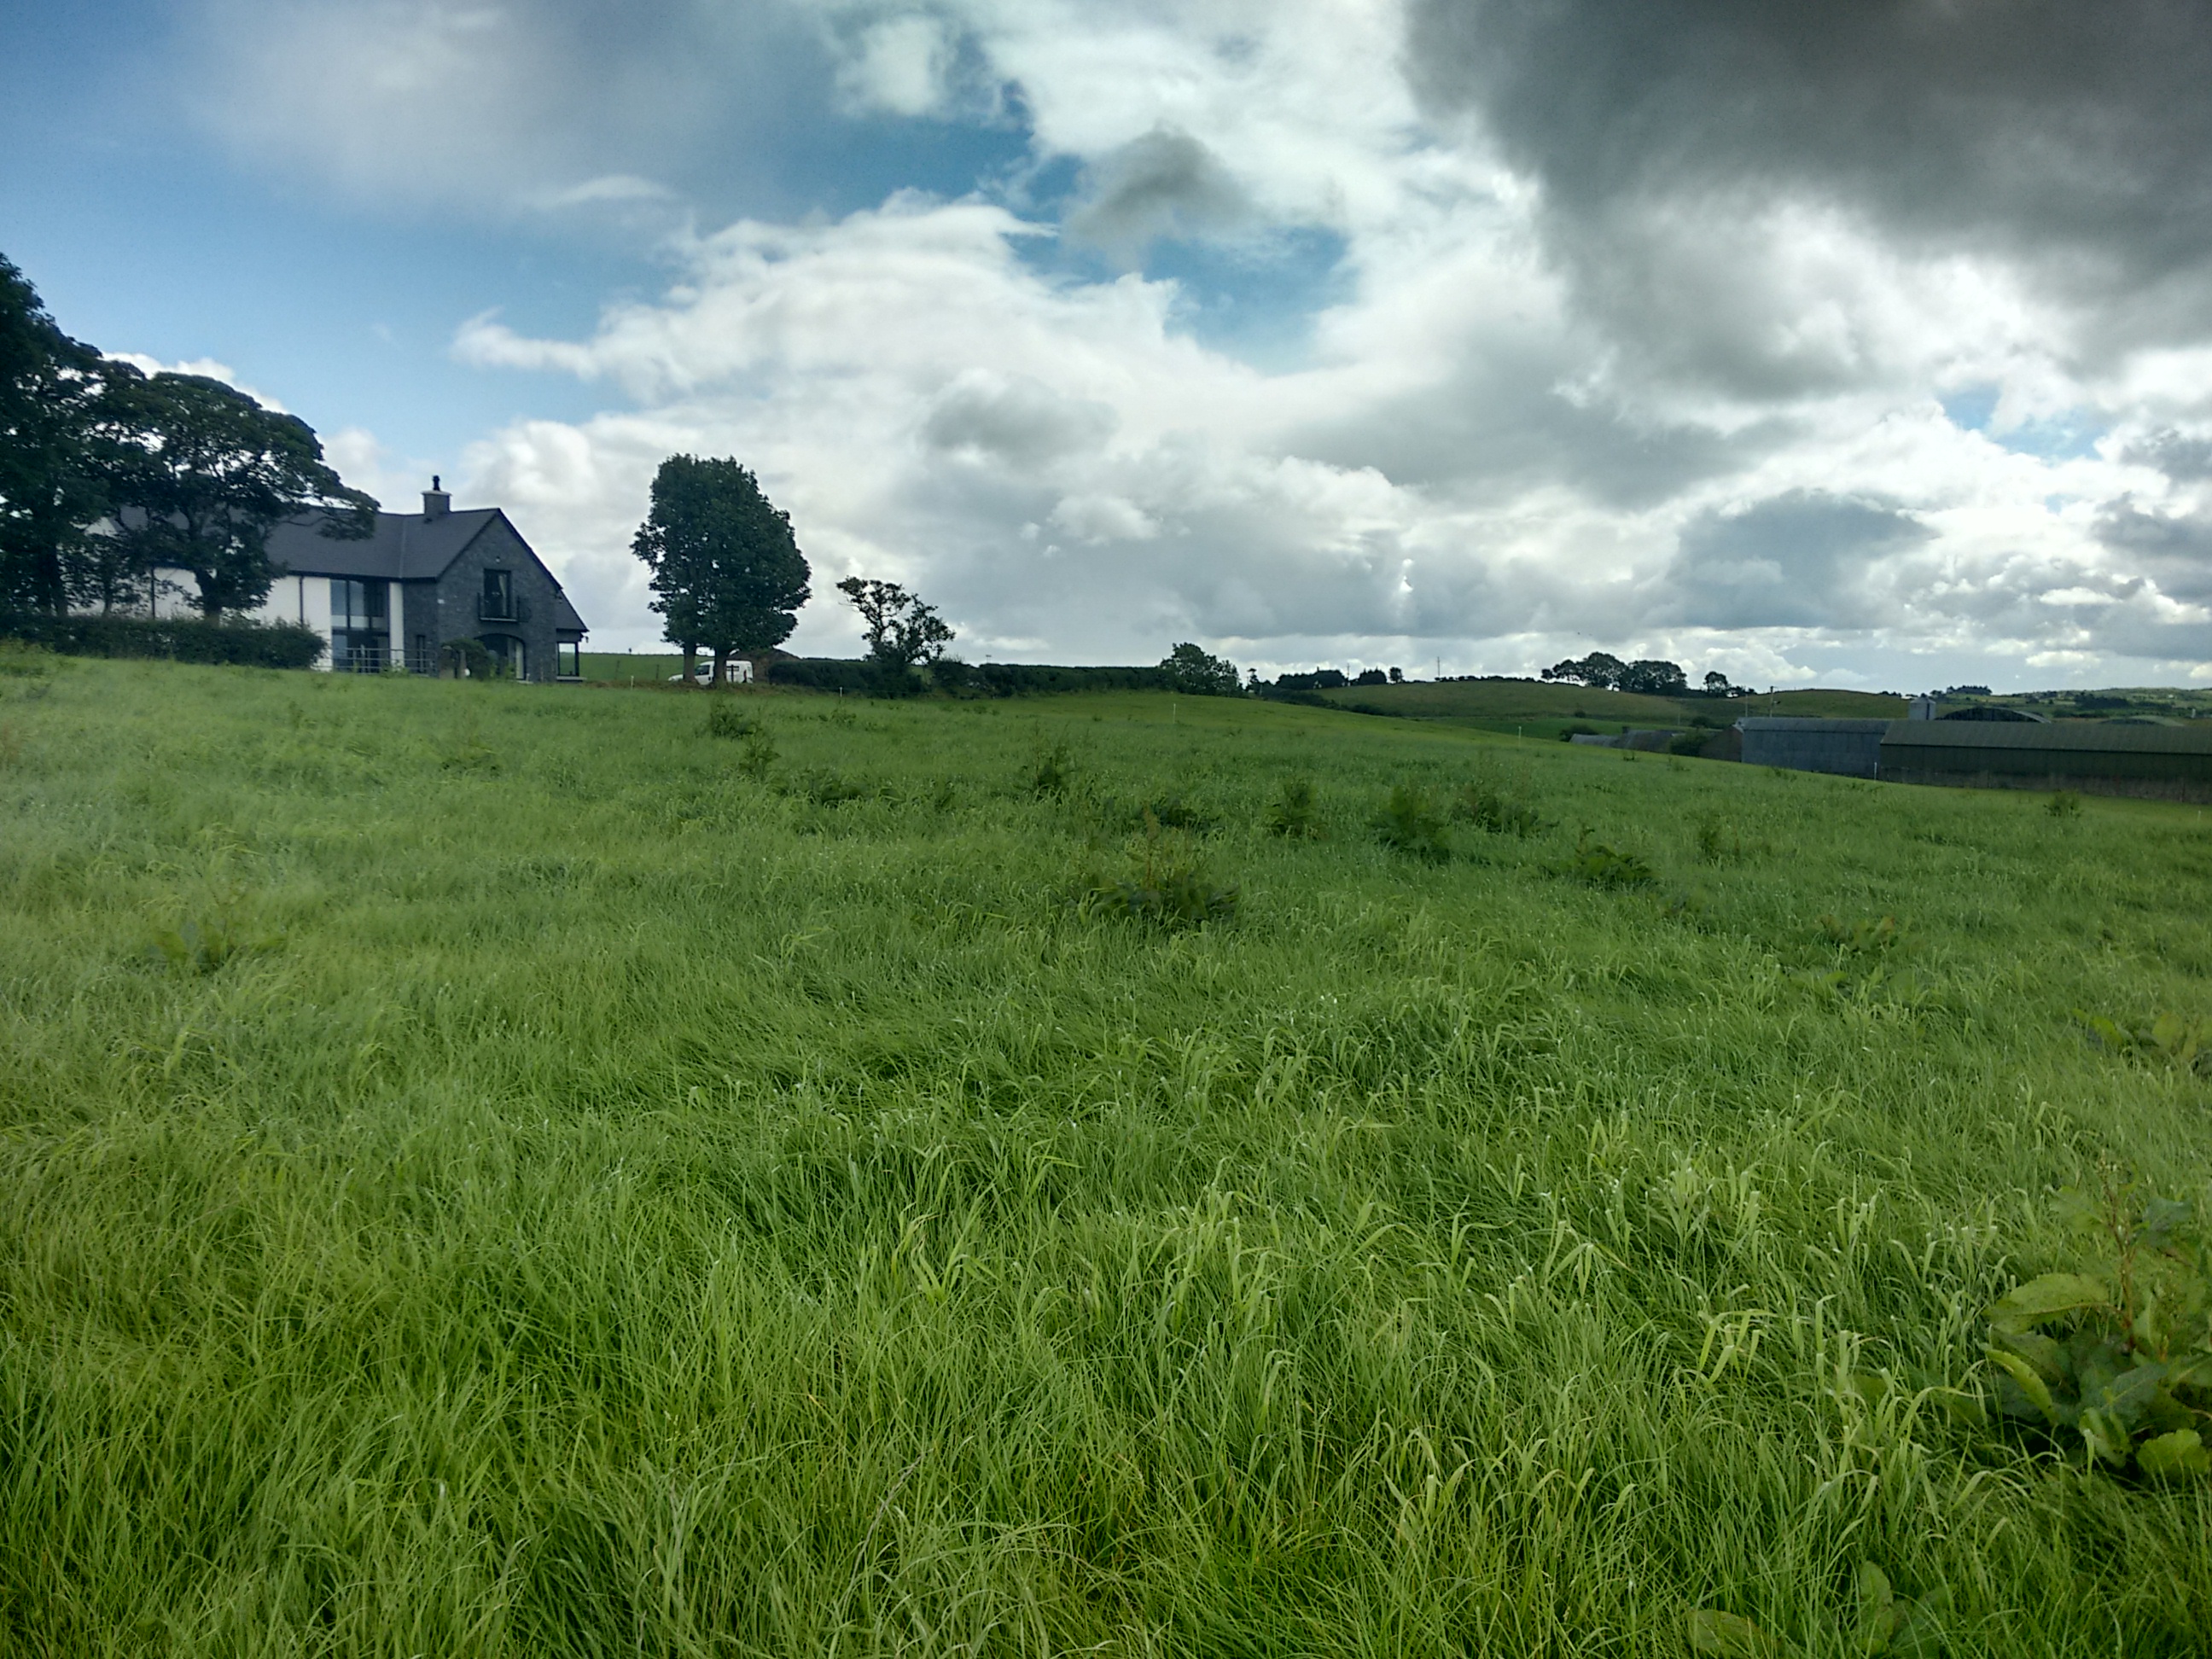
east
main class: Grassland
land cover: Grassland without tree/shrub cover
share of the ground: > 75 %
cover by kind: herbaceous plants 100 %
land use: Agriculture (excluding fallow land and kitchen gardens)
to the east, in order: Grassland without tree/shrub cover; Managed hedges; Fences; Tracks; Grassland without tree/shrub cover; Fences; Managed hedges; Tracks; Grass margins; Fences; Grassland without tree/shrub cover; Managed hedges; Fences; Grass margins; Tracks; Grass margins; Tracks; Fences; Grassland without tree/shrub cover
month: July
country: GB
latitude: 54.5989
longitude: -6.9956
